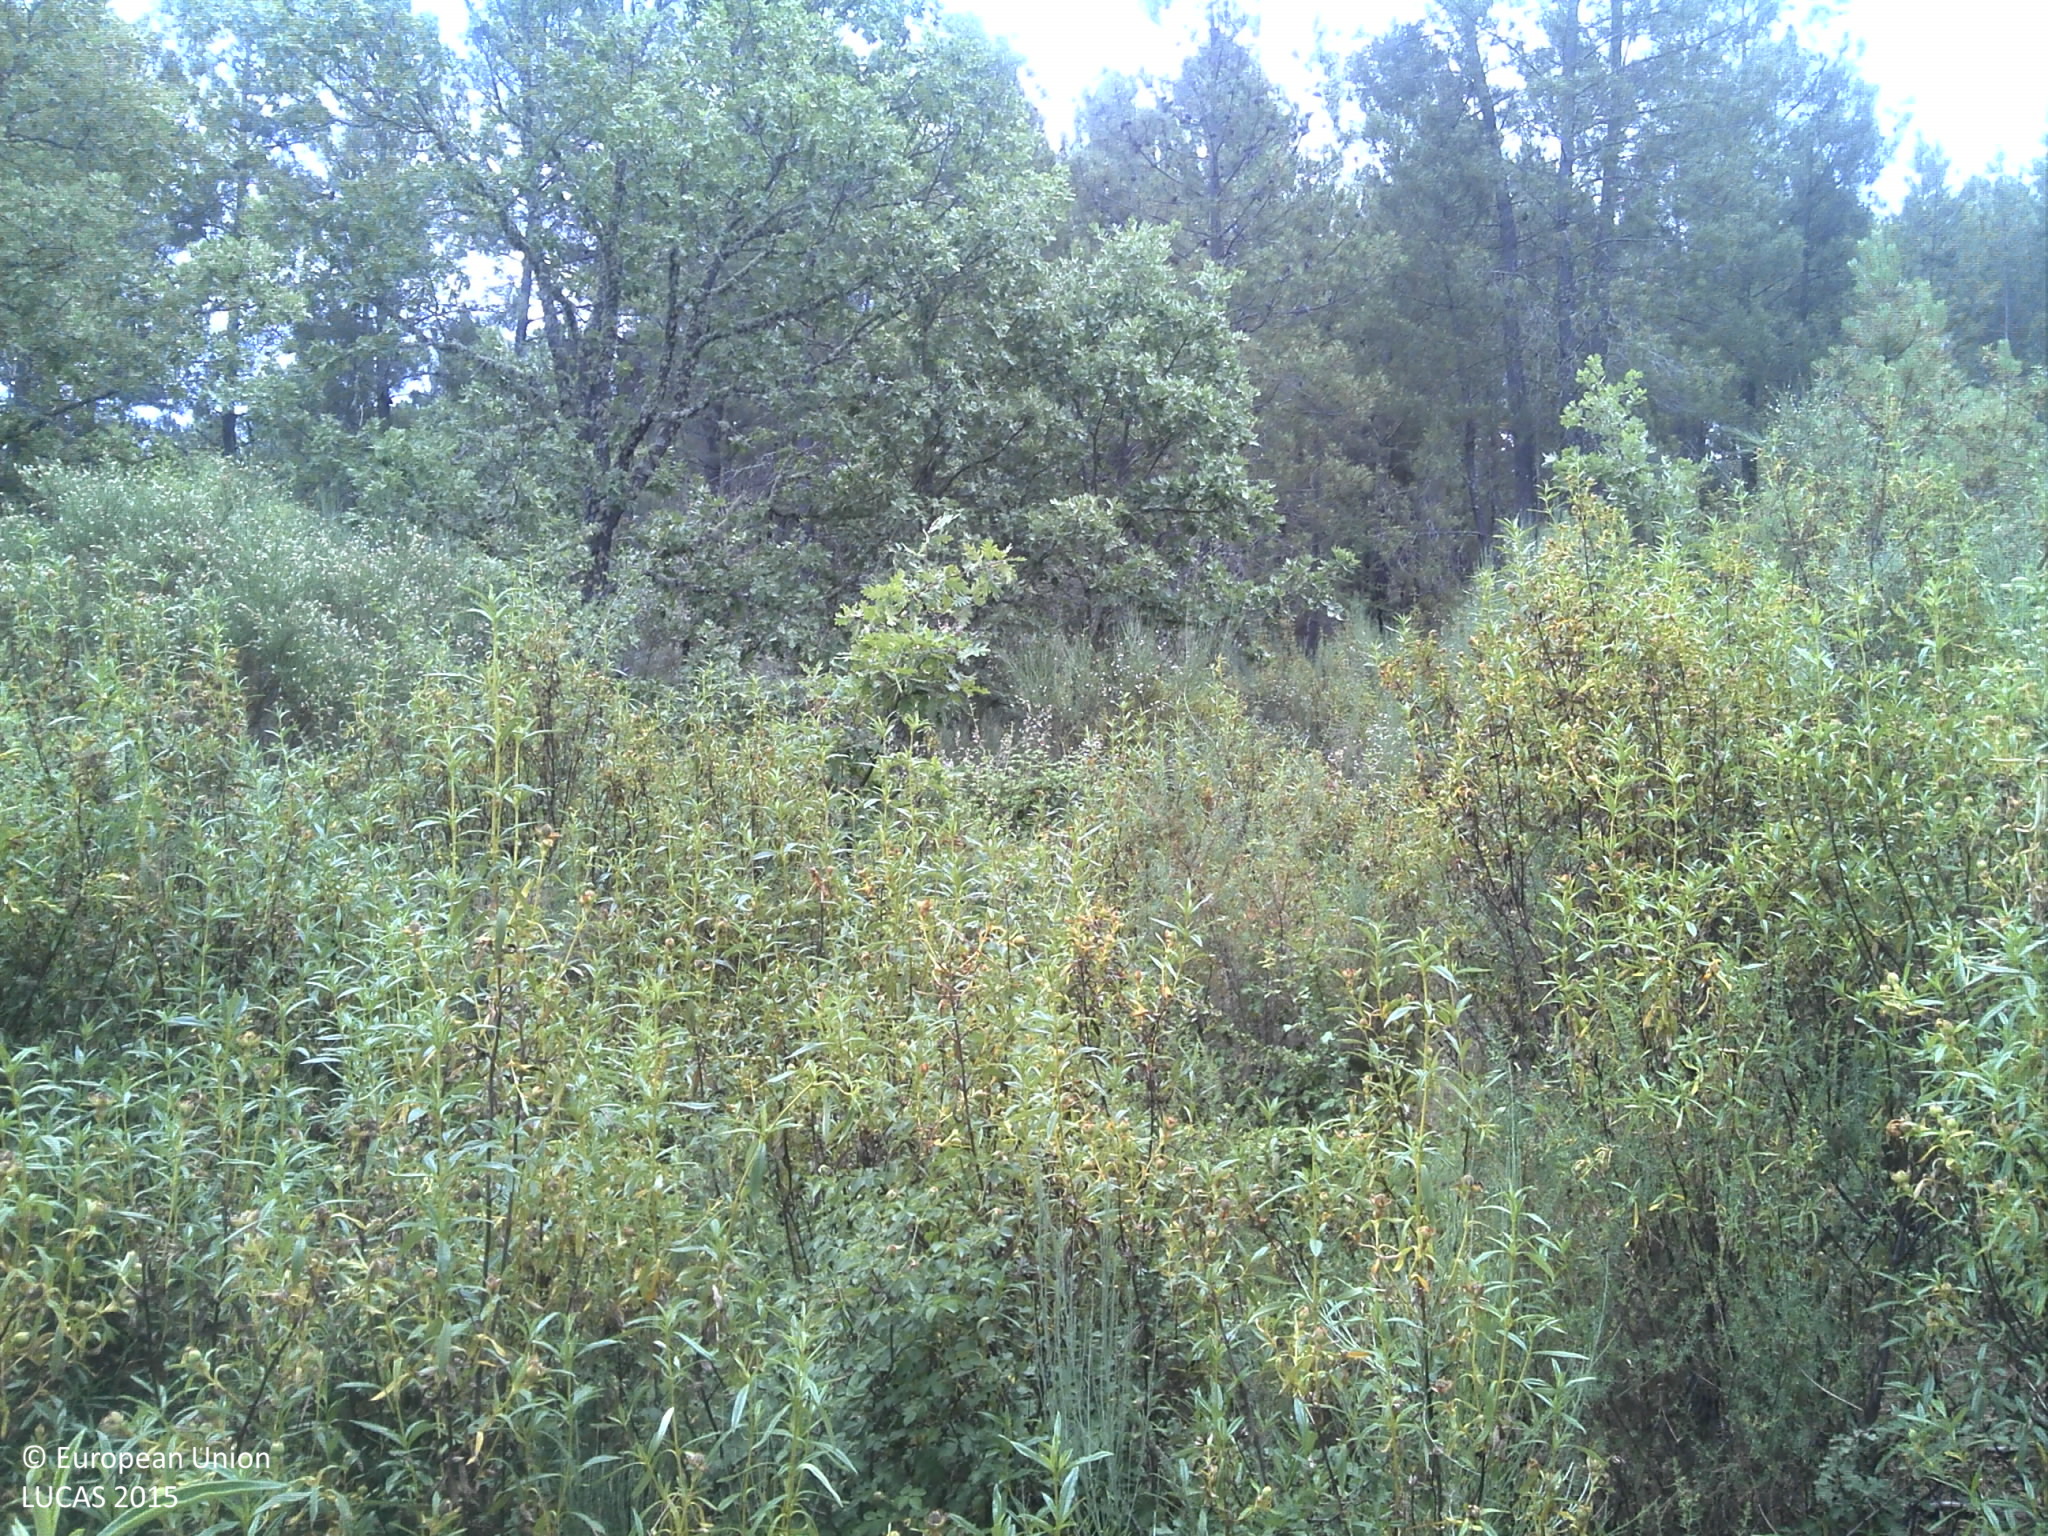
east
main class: Woodland
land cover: Pine dominated coniferous woodland
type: coniferous forest of the mediterranean region
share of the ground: 50 - 75 %
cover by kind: coniferous forest trees 60 %, shrubs 30 %, unconsolidated bare surface 5 %
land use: Forestry
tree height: > 5 m
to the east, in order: Pine dominated coniferous woodland; Tracks; Broadleaved woodland; Tracks; Broadleaved woodland
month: June
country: PT
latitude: 40.2133
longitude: -7.2911
